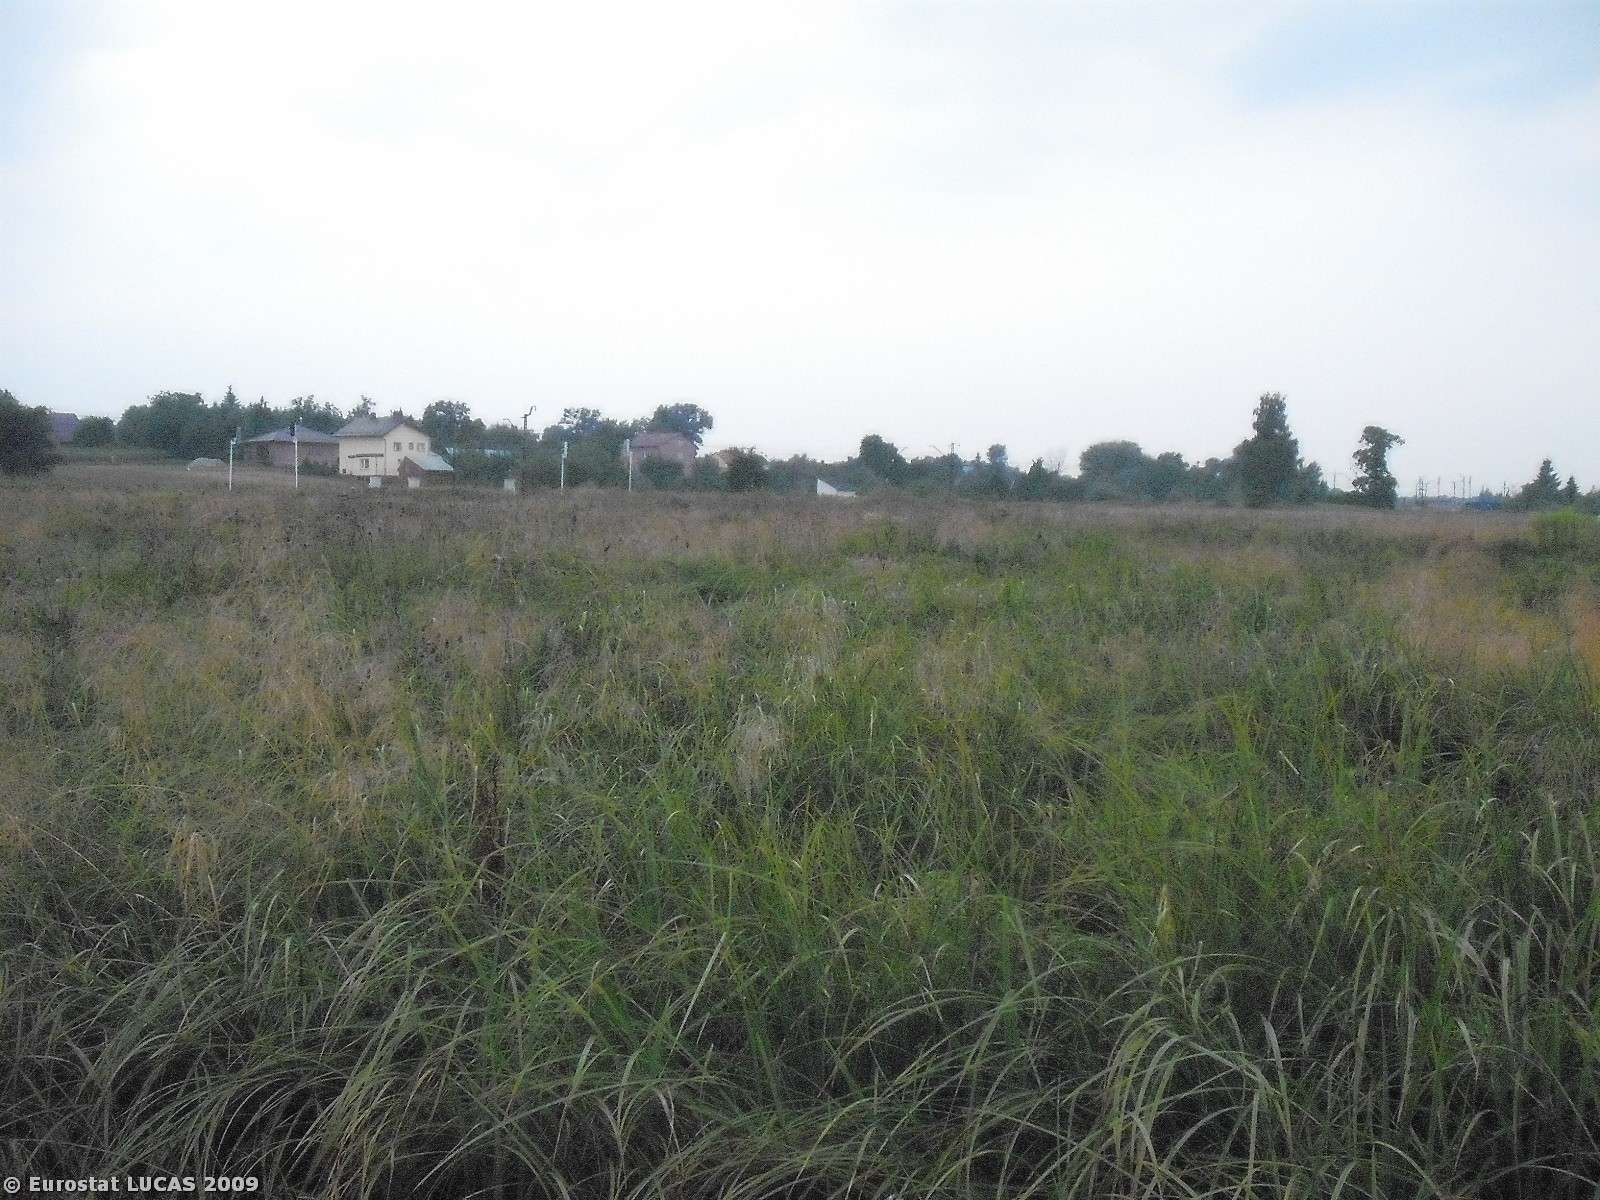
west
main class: Grassland
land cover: Grassland without tree/shrub cover
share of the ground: > 75 %
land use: Agriculture (excluding fallow land and kitchen gardens)
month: August
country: PL
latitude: 50.0799
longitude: 22.4599
